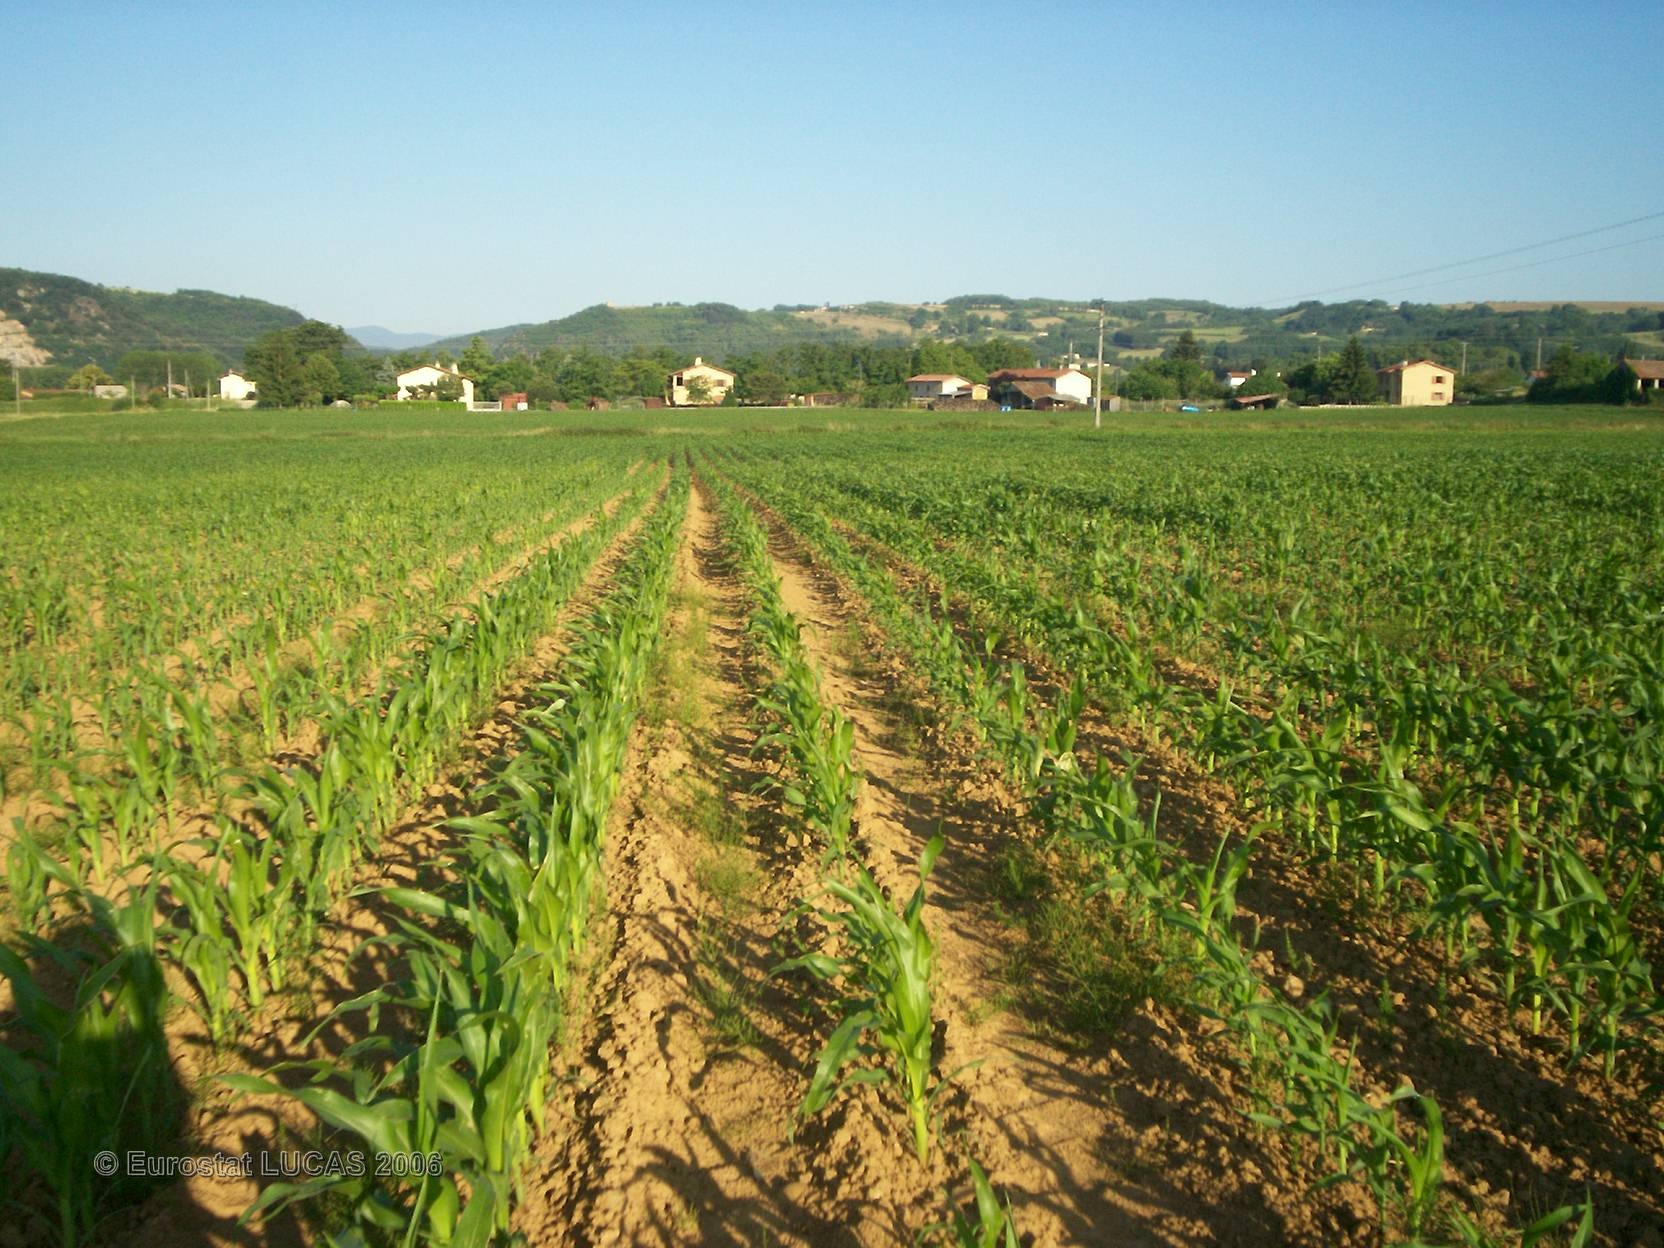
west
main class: Cropland
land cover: Maize
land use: Agriculture (excluding fallow land and kitchen gardens)
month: June
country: FR
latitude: 45.1814
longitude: 4.8764
